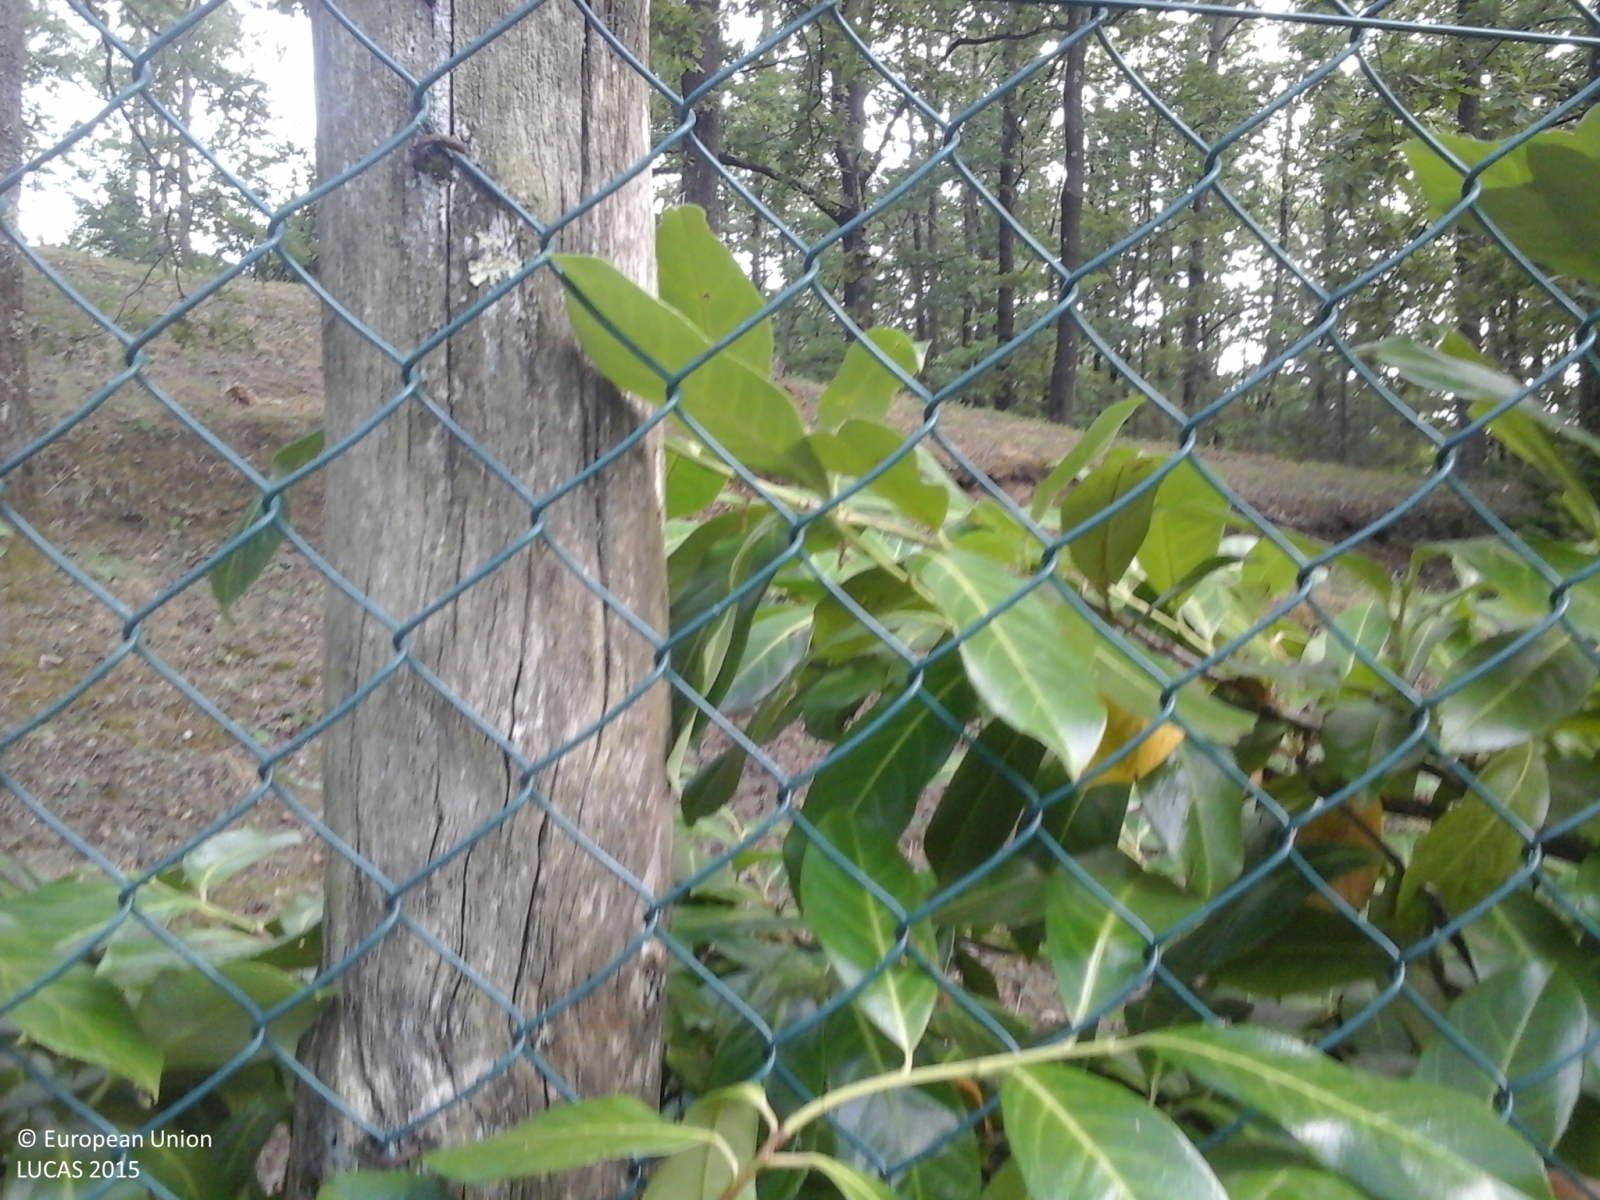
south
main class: Woodland
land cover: Broadleaved woodland
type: thermophilous deciduous forest
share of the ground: > 75 %
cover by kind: broadleaved forest trees 95 %, herbaceous plants 5 %
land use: Amenities, museums, leisure
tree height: > 5 m
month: August
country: IT
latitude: 43.9339
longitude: 10.6088
